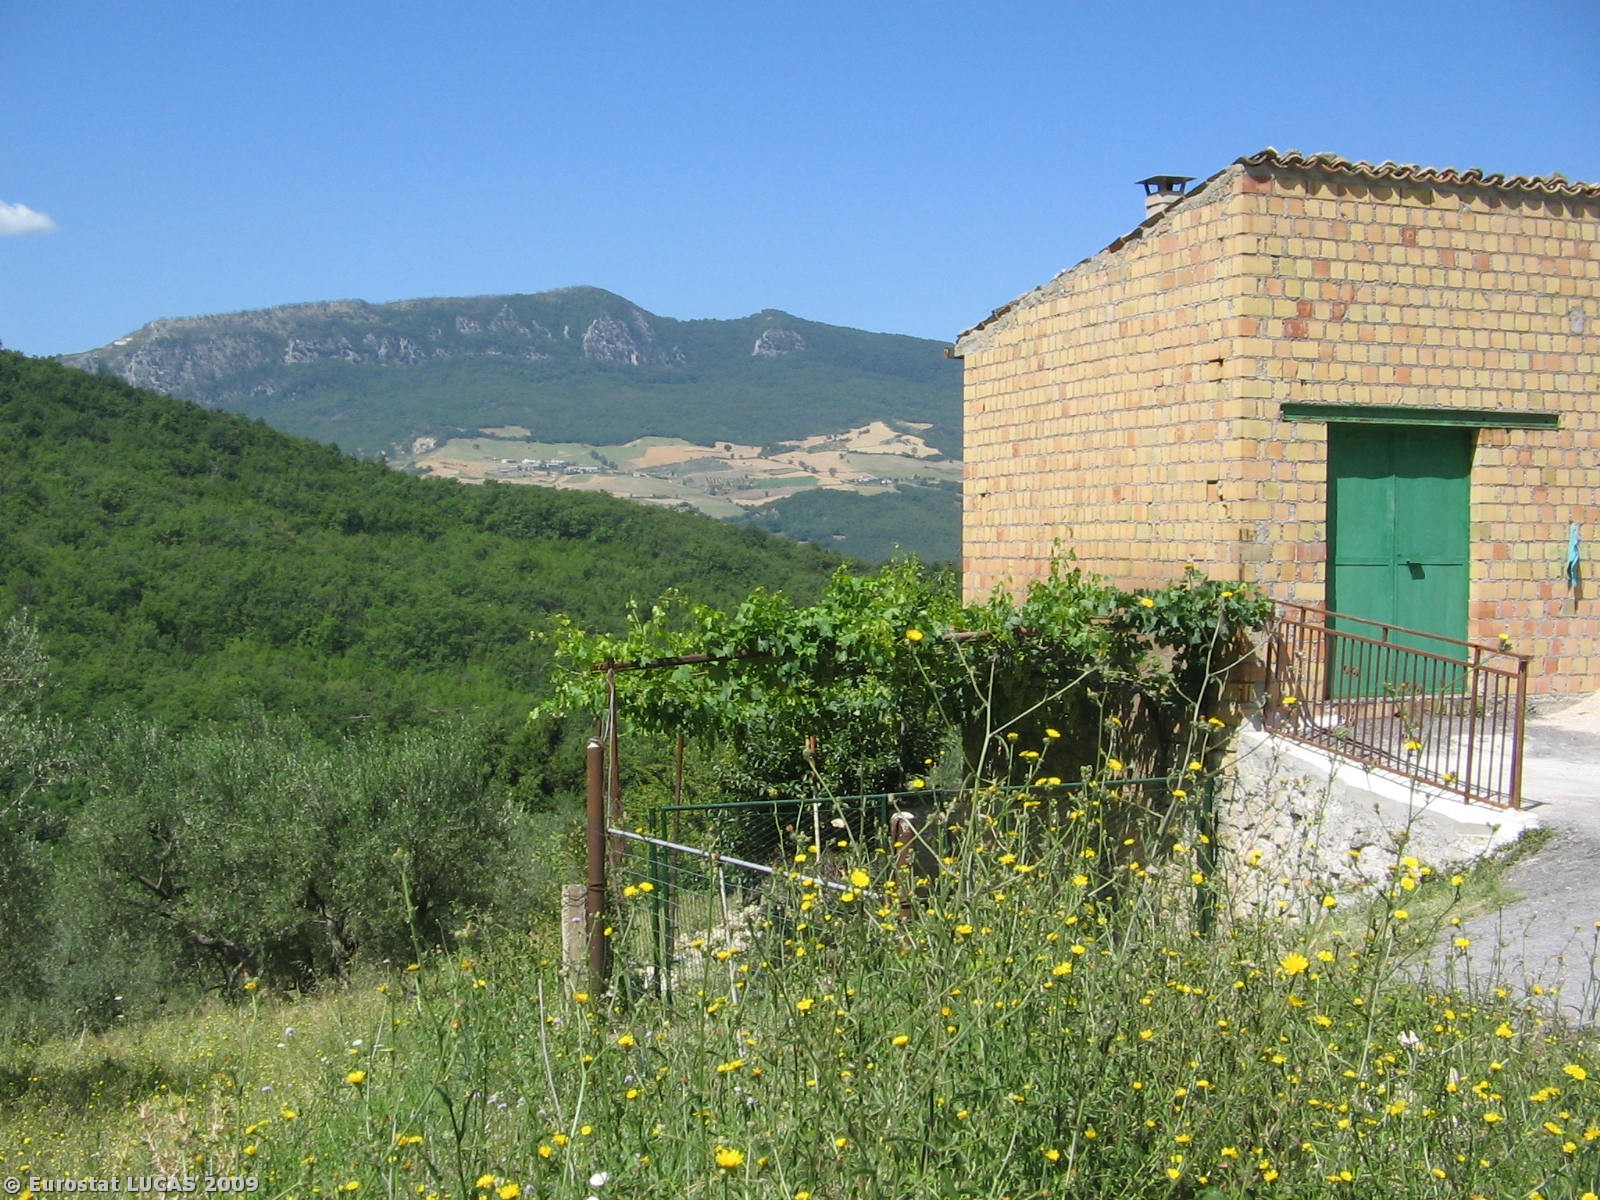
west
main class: Grassland
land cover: Grassland with sparse tree/shrub cover
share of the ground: > 75 %
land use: Agriculture (excluding fallow land and kitchen gardens)
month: July
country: IT
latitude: 41.9800
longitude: 14.3910
